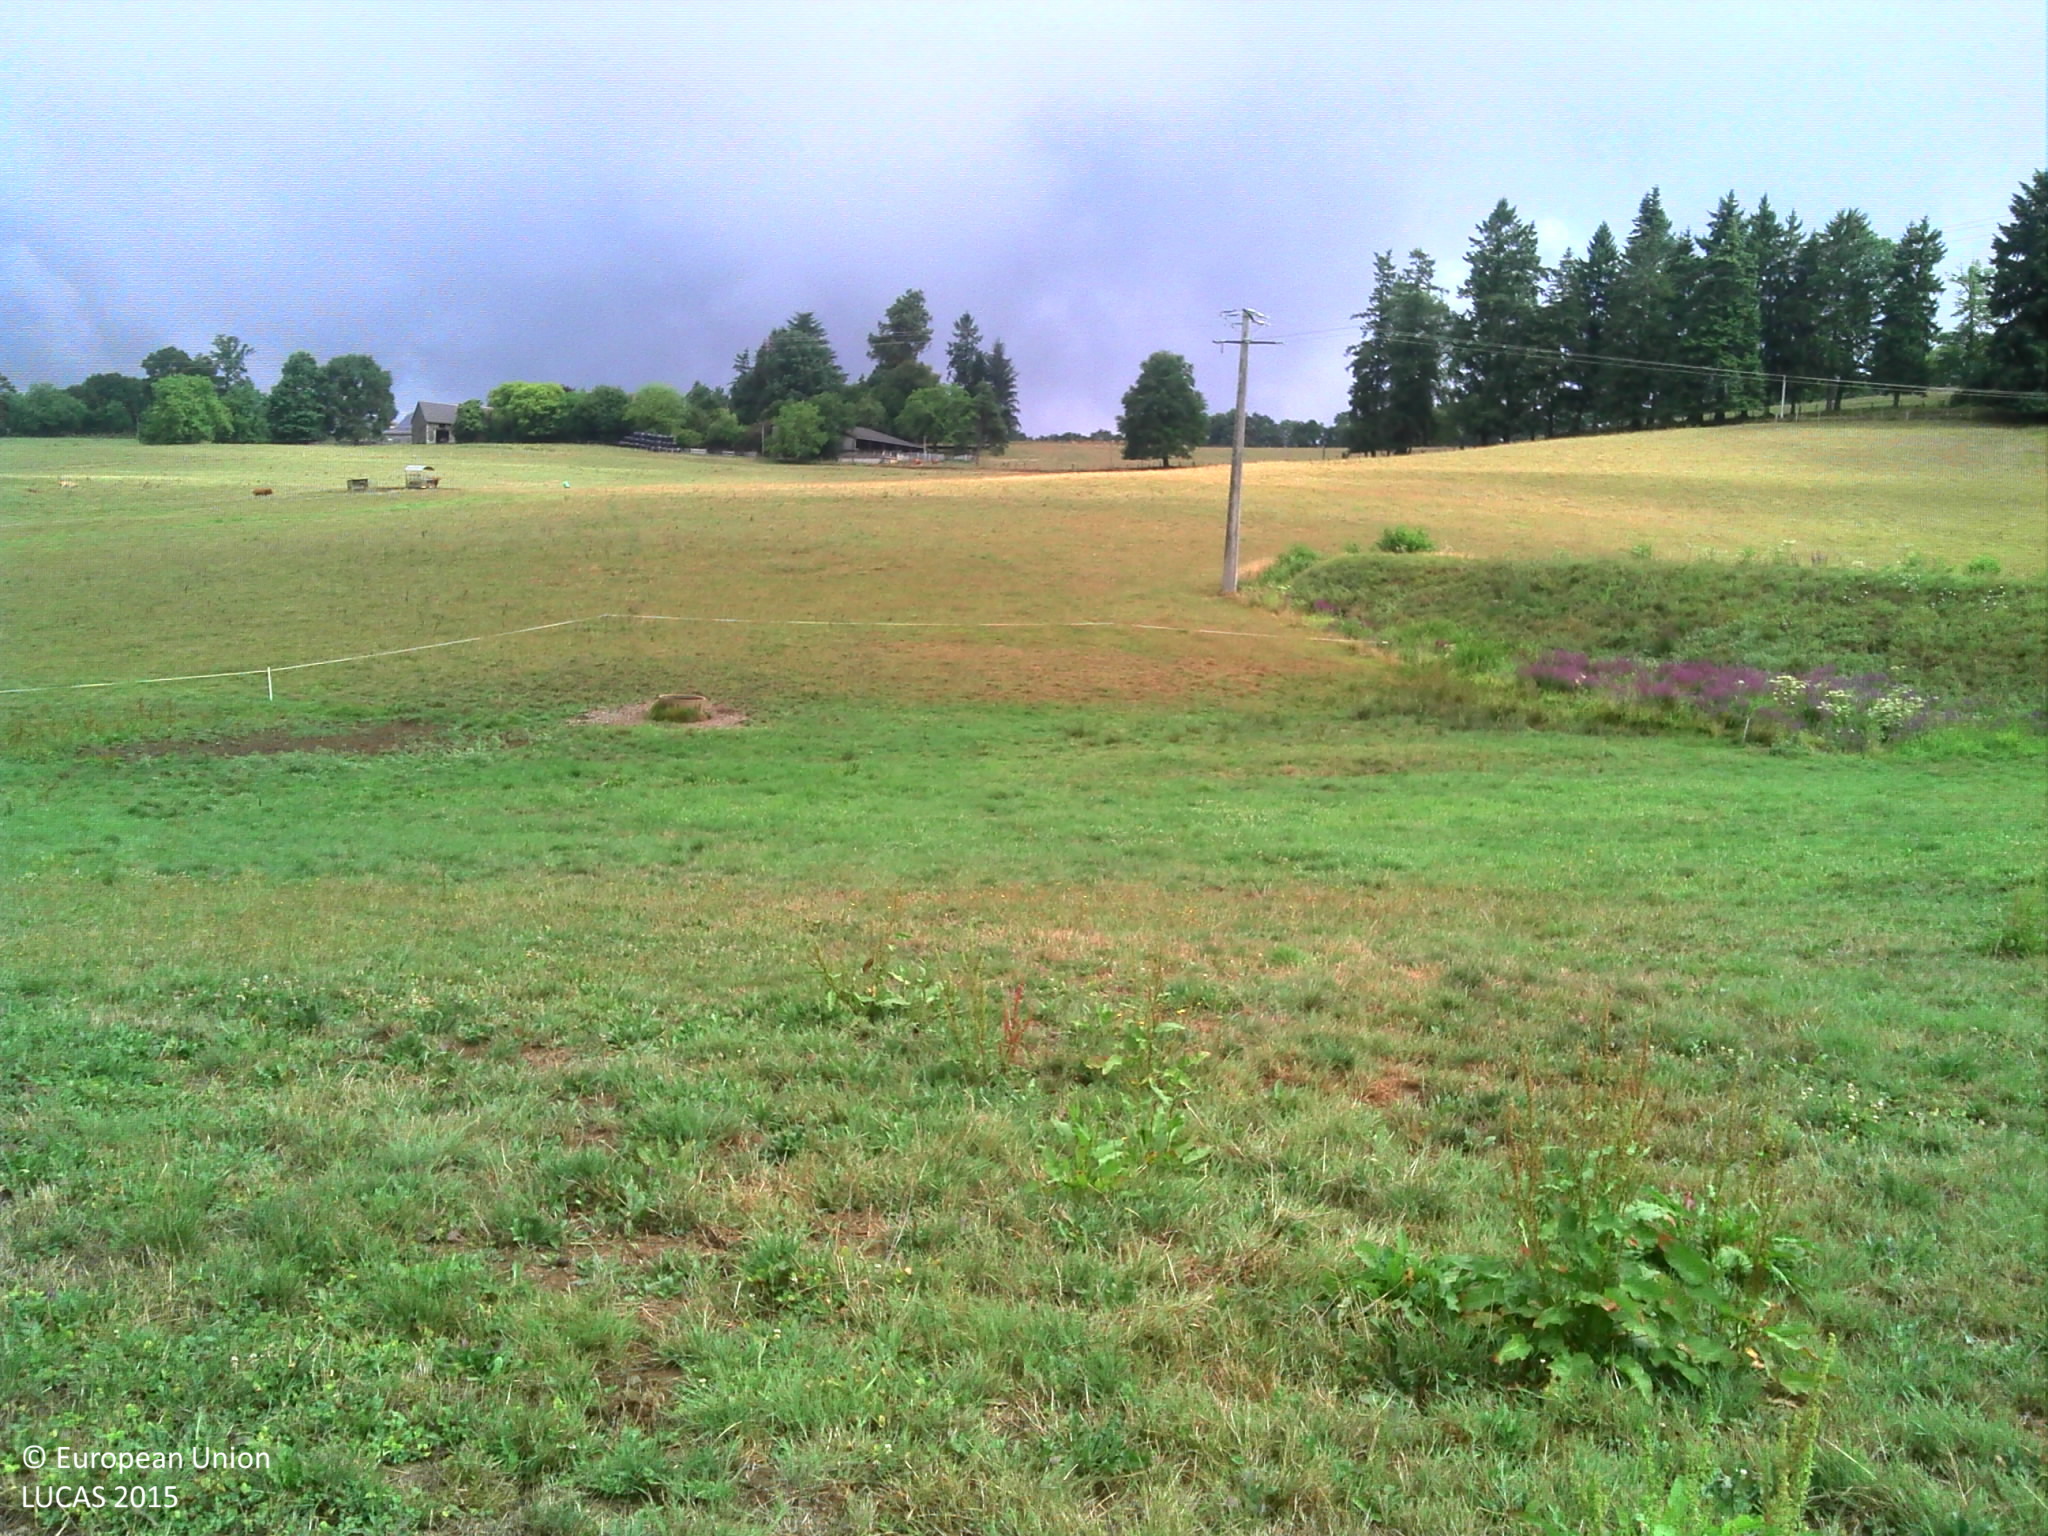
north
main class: Grassland
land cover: Grassland without tree/shrub cover
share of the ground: > 75 %
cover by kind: herbaceous plants 100 %
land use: Agriculture (excluding fallow land and kitchen gardens)
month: August
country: FR
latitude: 45.4108
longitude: 1.6768
